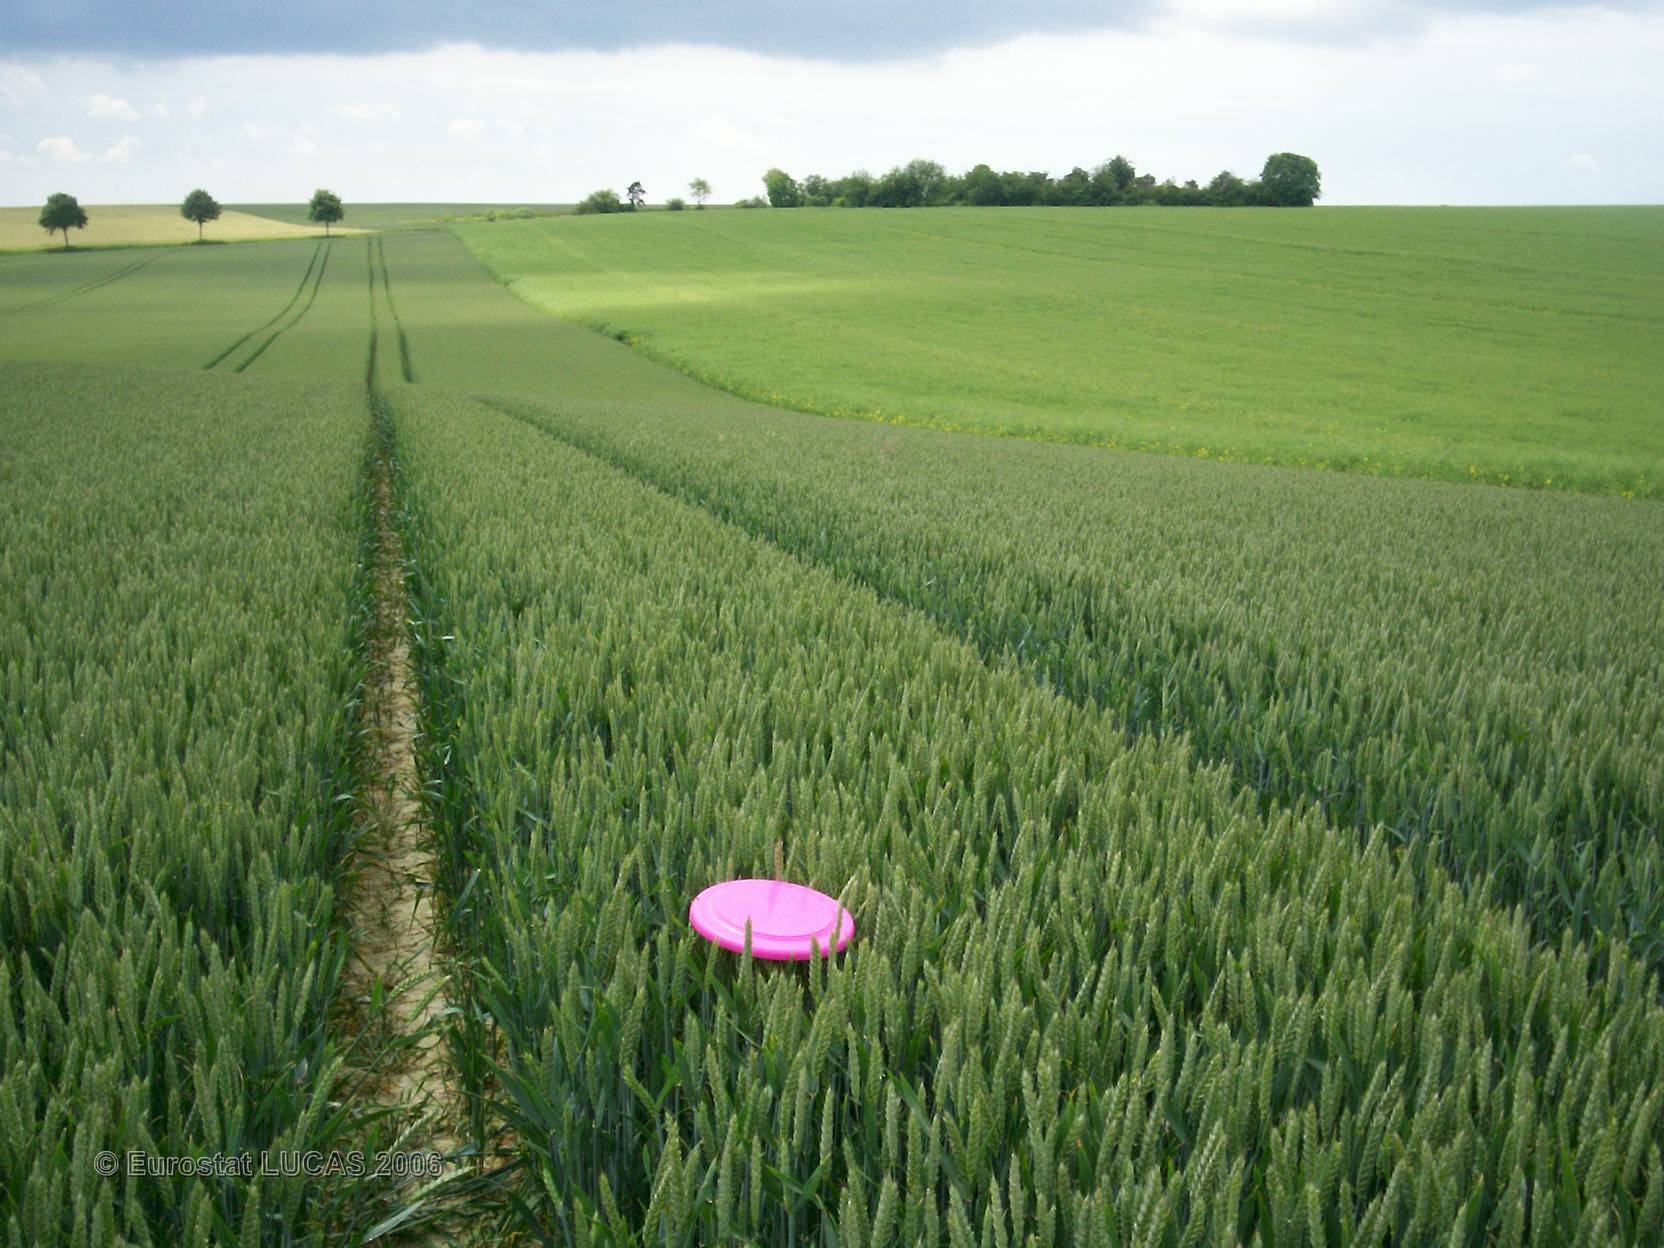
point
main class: Cropland
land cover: Common wheat
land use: Agriculture (excluding fallow land and kitchen gardens)
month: June
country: FR
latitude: 48.6081
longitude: 4.4771
